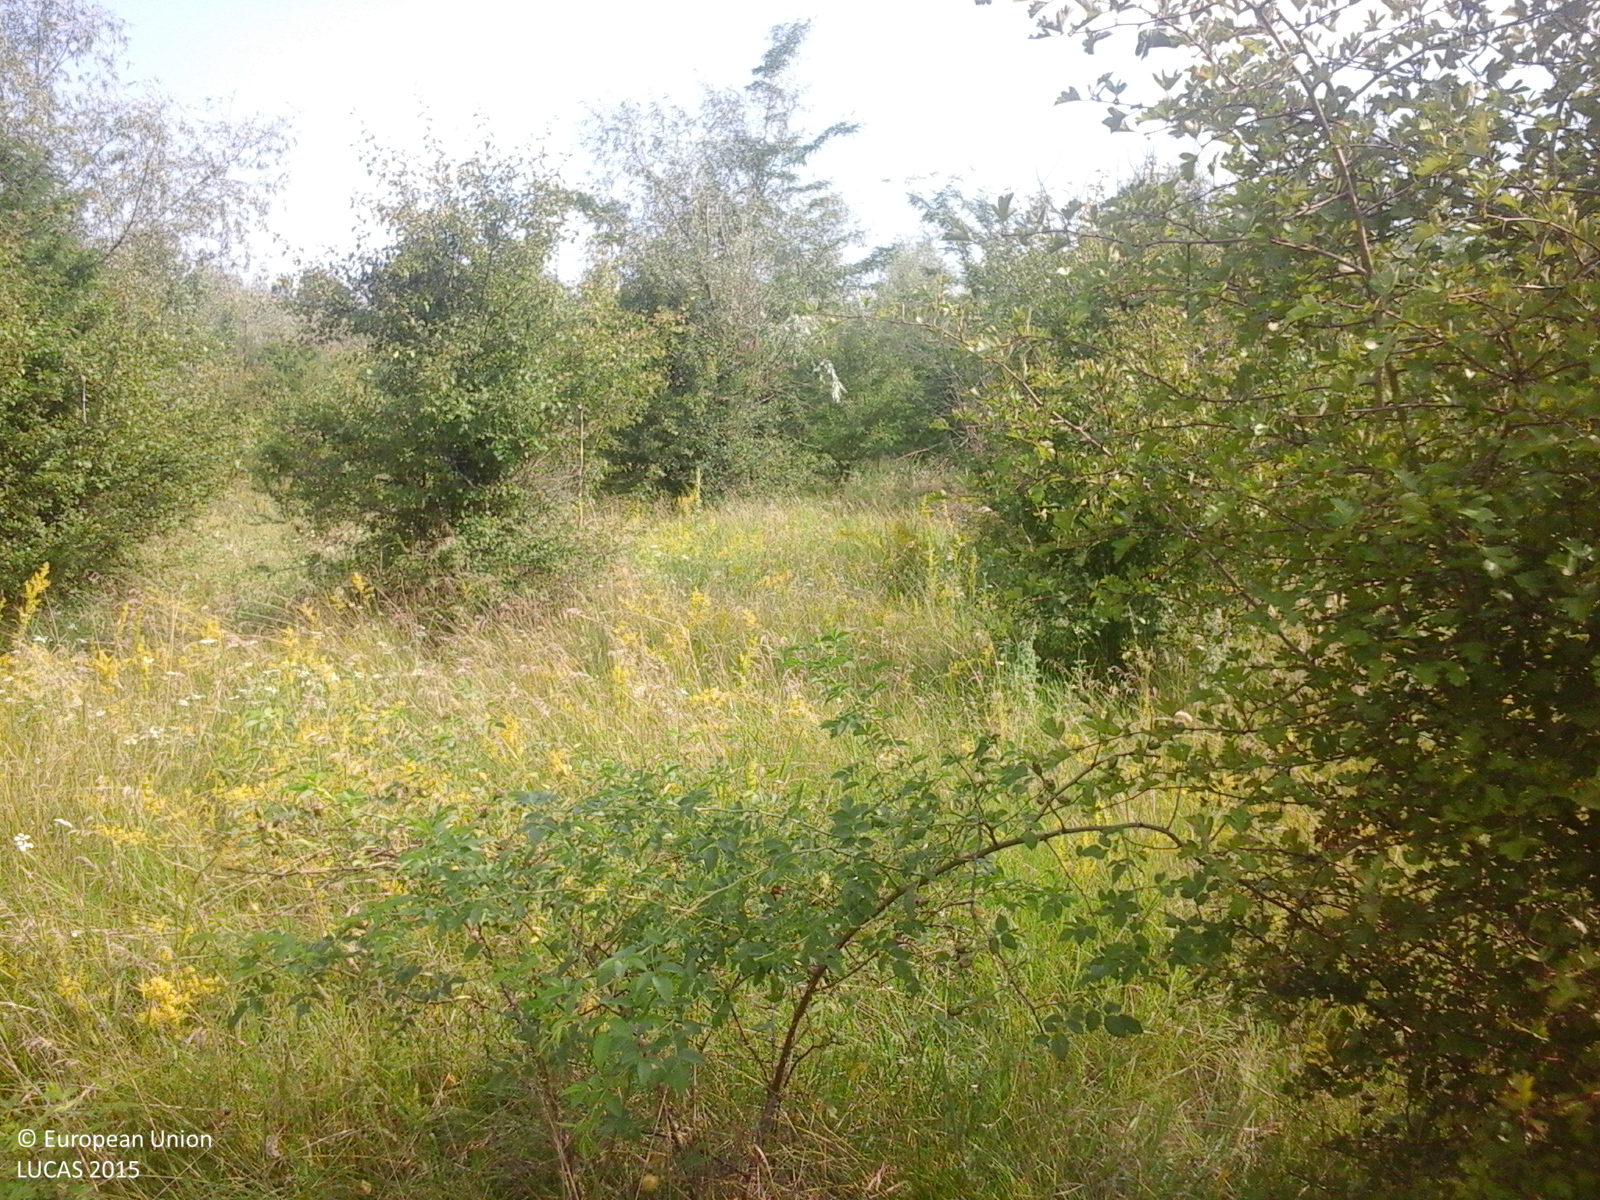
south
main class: Grassland
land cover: Grassland with sparse tree/shrub cover
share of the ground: > 75 %
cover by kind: herbaceous plants 85 %, shrubs 10 %, broadleaved forest trees 5 %
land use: Agriculture (excluding fallow land and kitchen gardens)
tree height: > 5 m
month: July
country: RO
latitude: 43.8237
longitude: 24.7290
